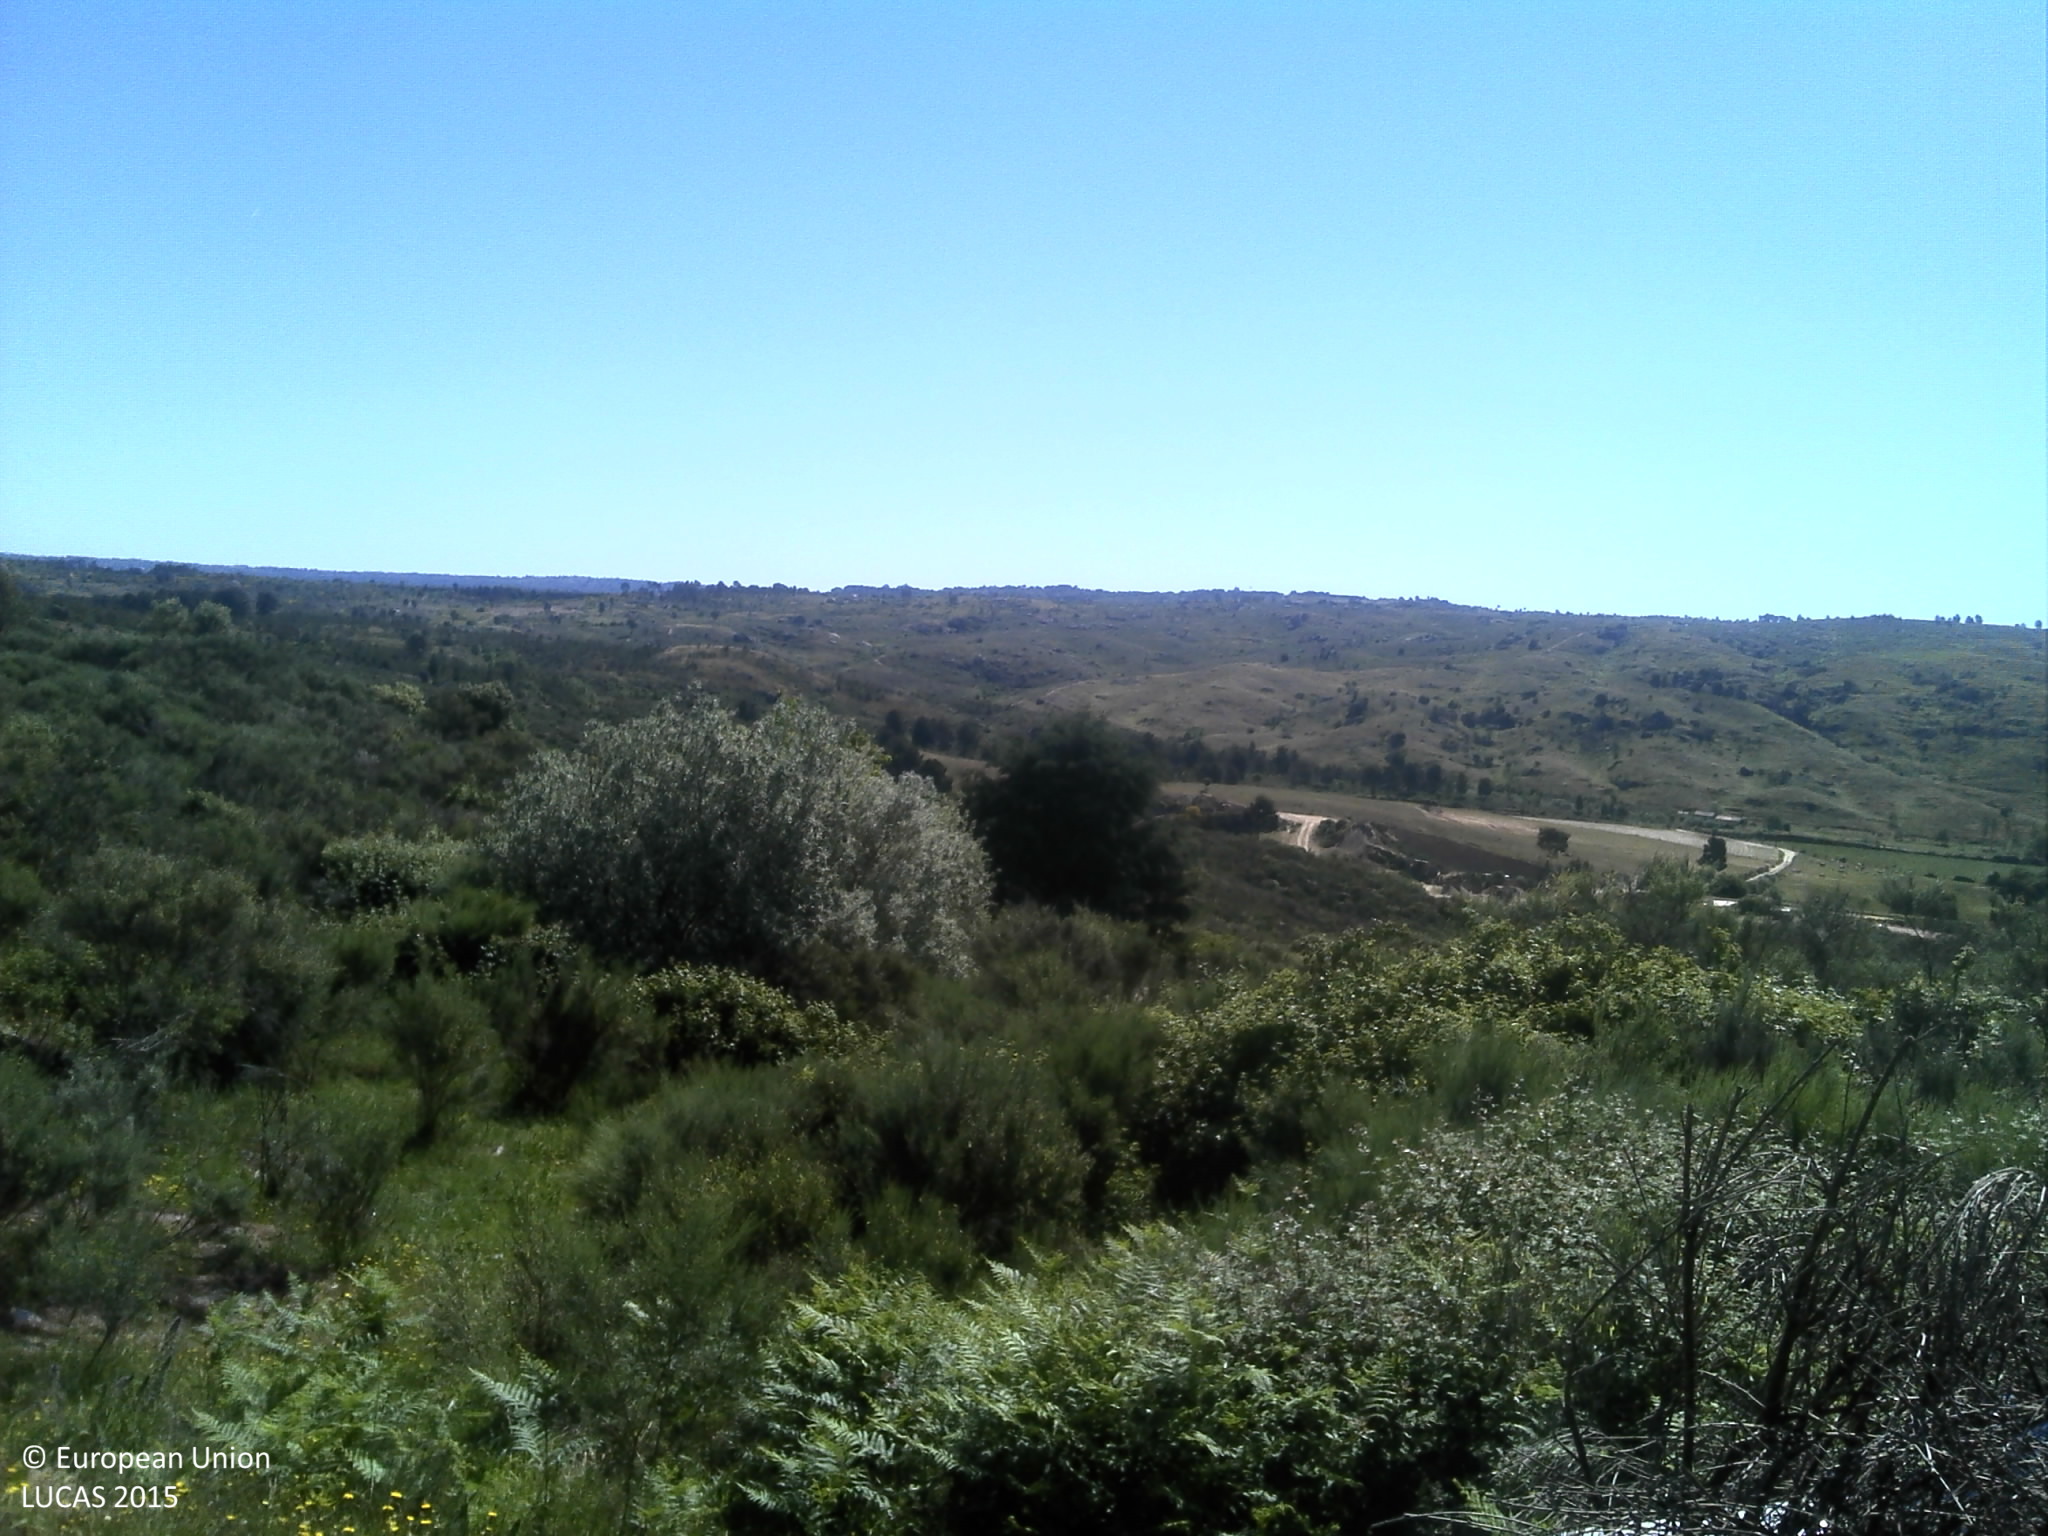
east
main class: Shrubland
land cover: Shrubland without tree cover
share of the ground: 50 - 75 %
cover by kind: shrubs 70 %, herbaceous plants 20 %, unconsolidated bare surface 10 %
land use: Abandoned areas
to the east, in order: Shrubland without tree cover; Tracks; Shrubland without tree cover; Tracks; Shrubland without tree cover; Tracks; Shrubland without tree cover
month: May
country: PT
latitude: 40.6947
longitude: -7.2799
